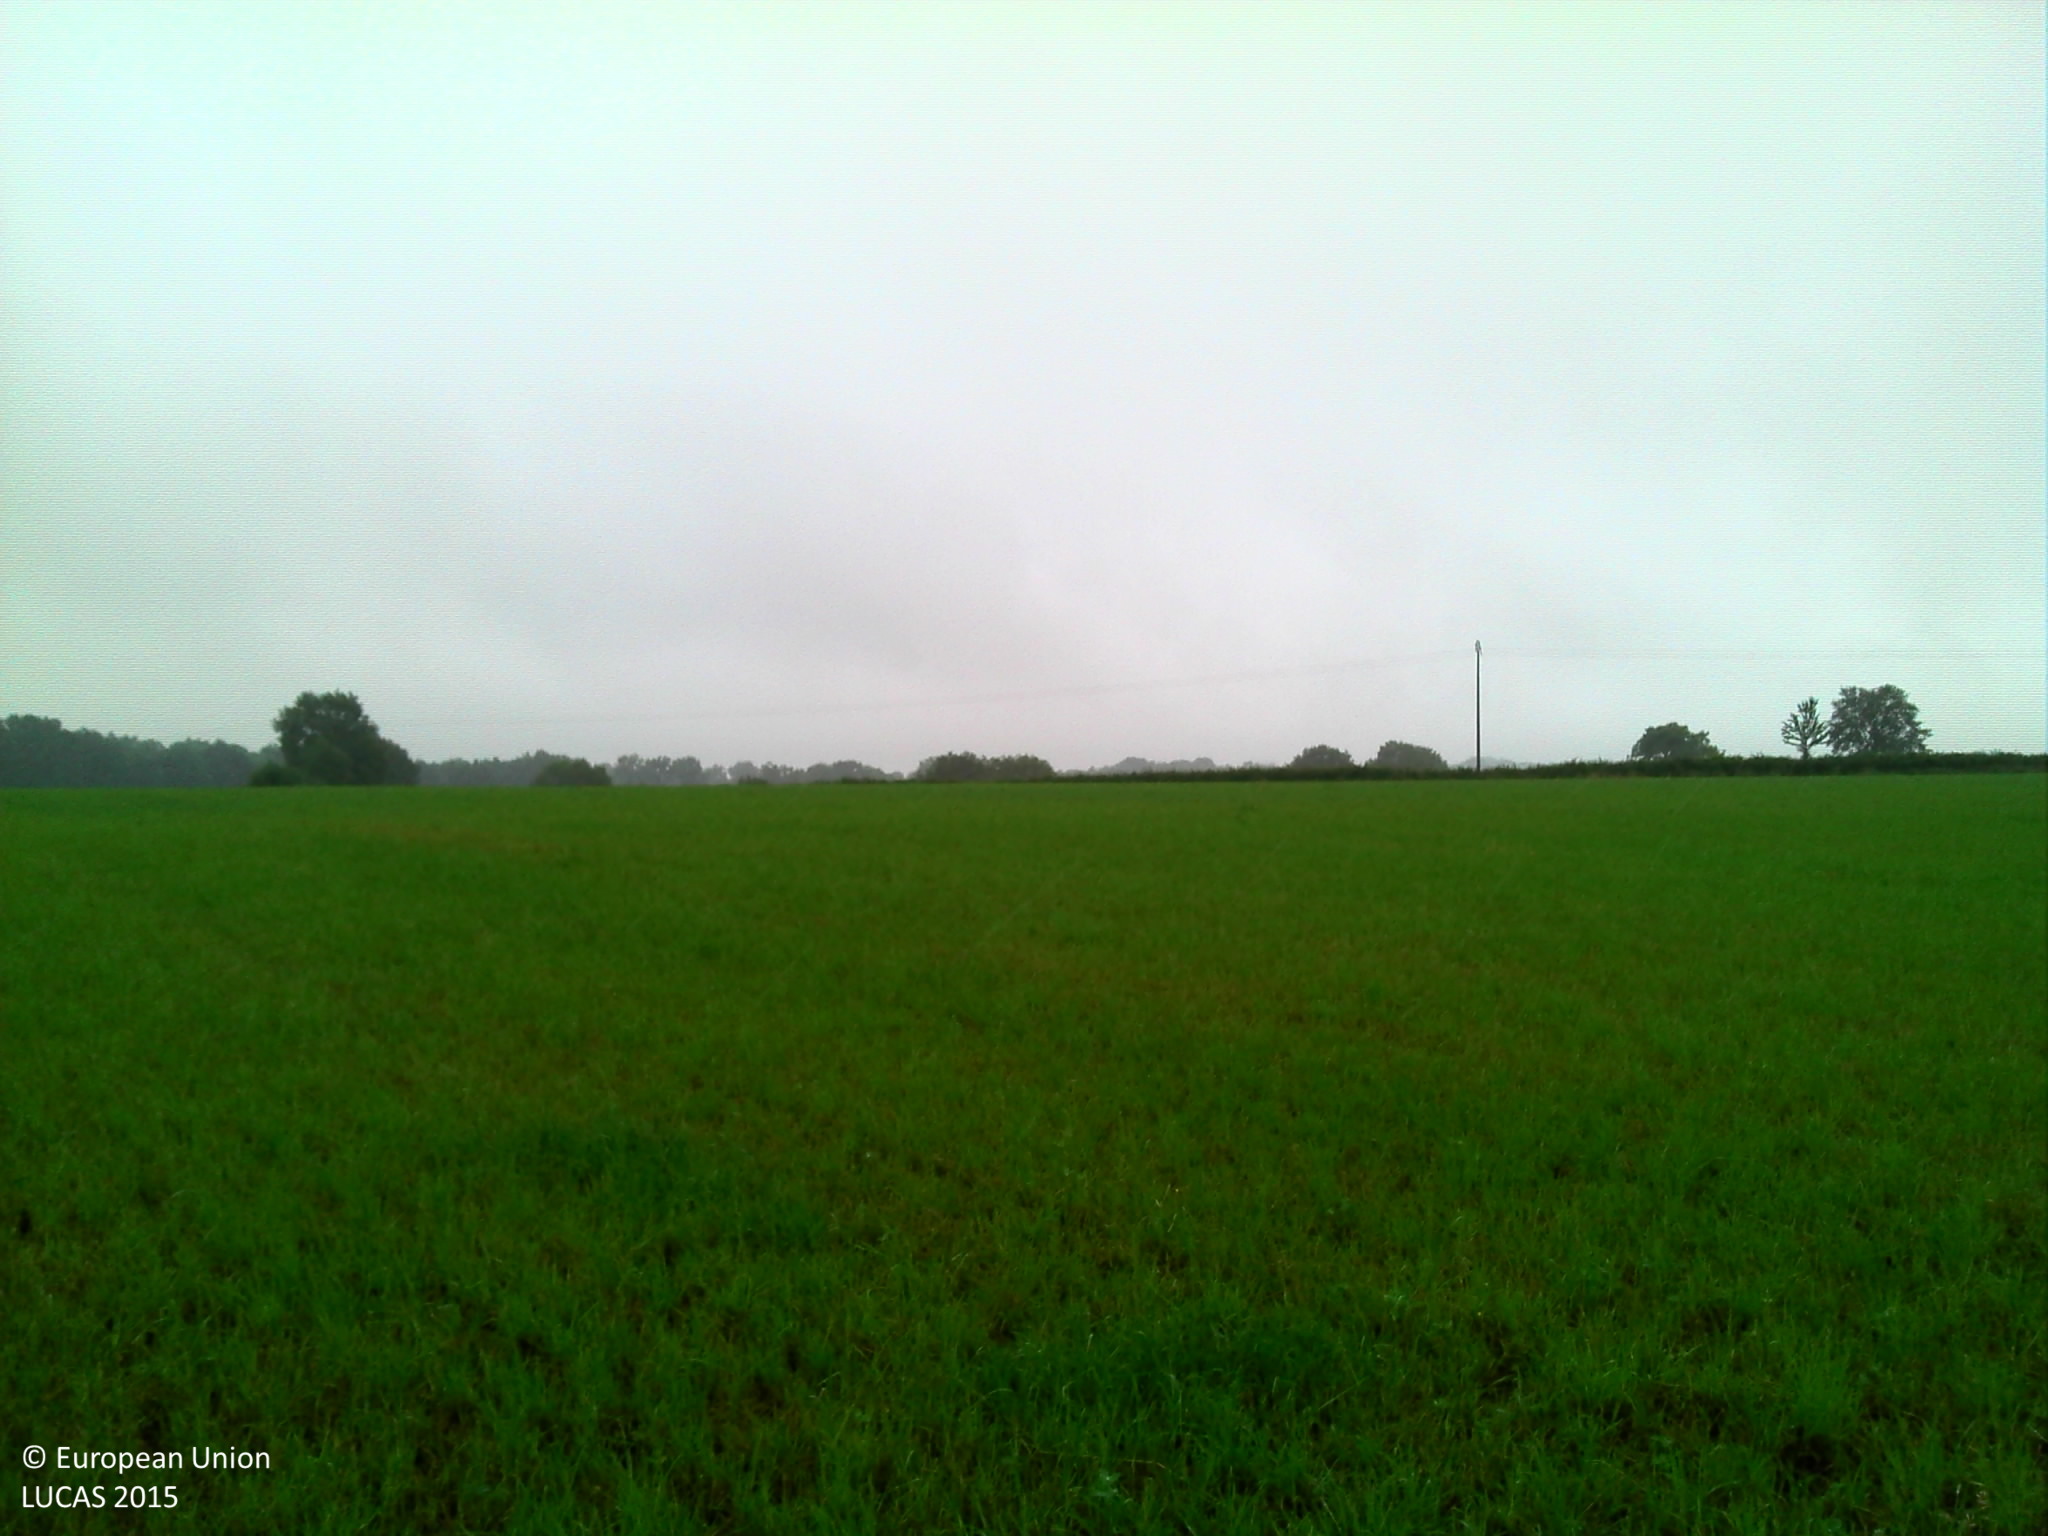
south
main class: Cropland
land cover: Temporary grasslands
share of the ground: > 75 %
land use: Agriculture (excluding fallow land and kitchen gardens)
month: June
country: FR
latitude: 46.4459
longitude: 2.9809
